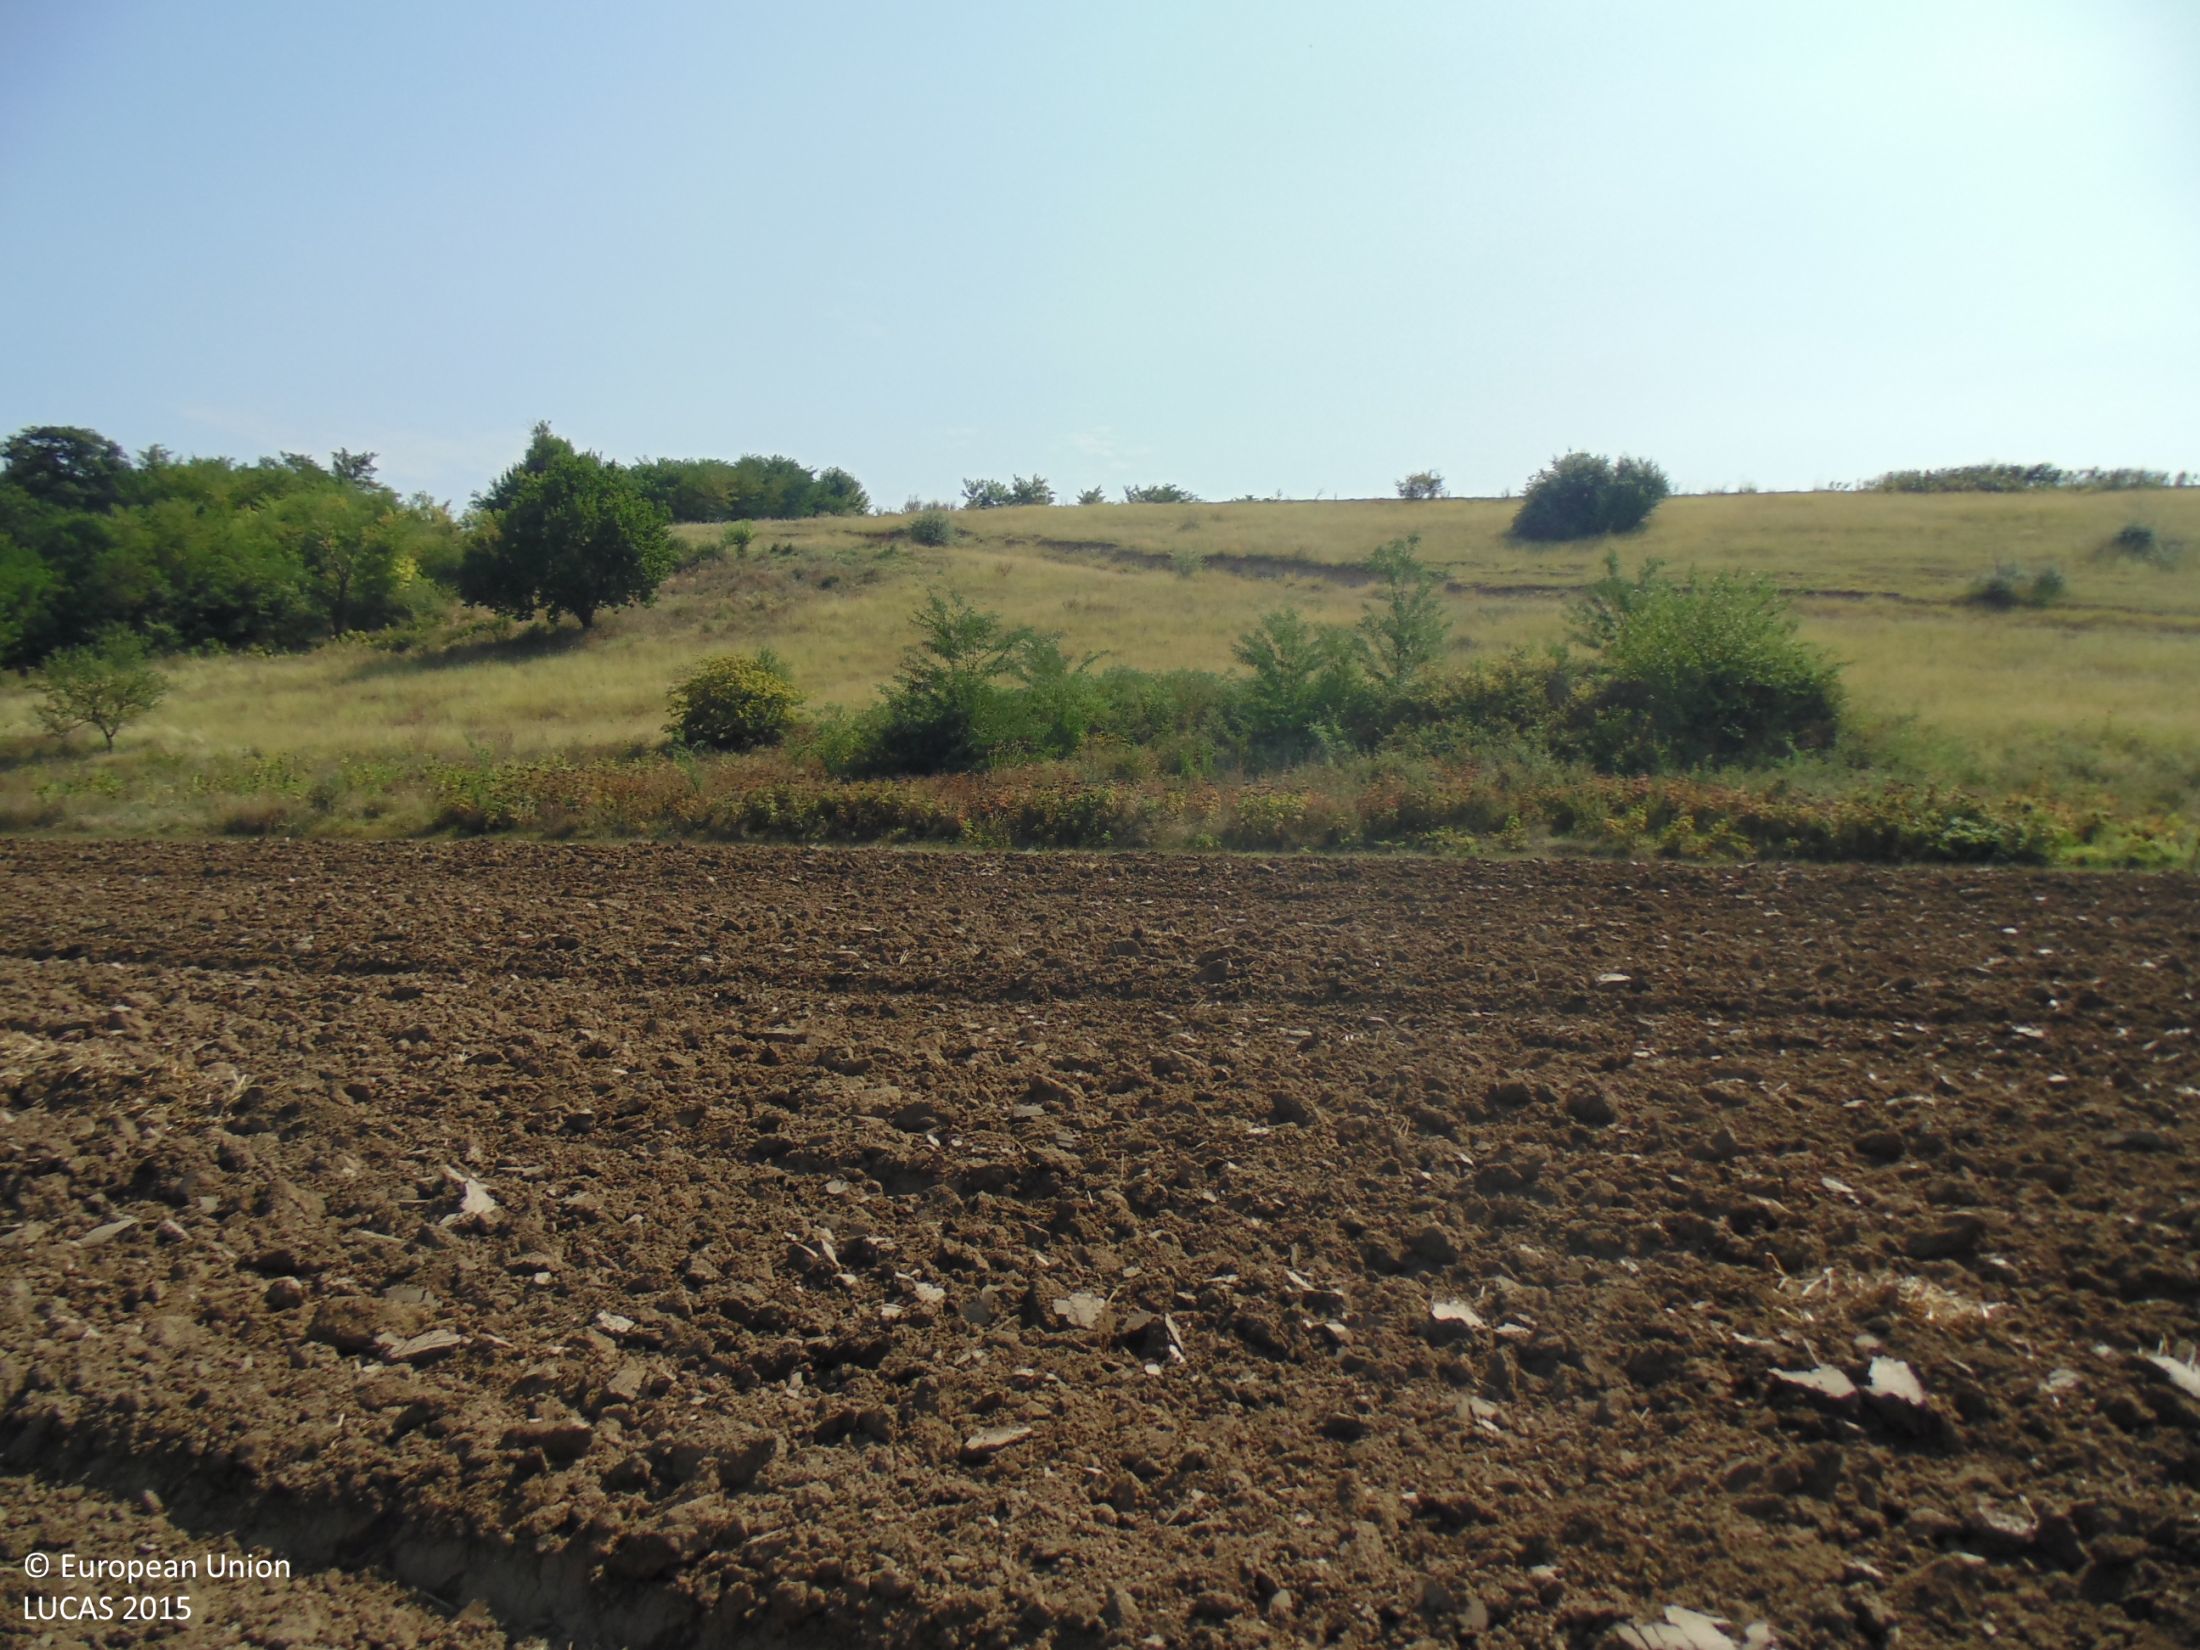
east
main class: Cropland
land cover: Common wheat
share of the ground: < 10 %
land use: Agriculture (excluding fallow land and kitchen gardens)
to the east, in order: Common wheat; Grass margins; Tracks; Grassland with sparse tree/shrub cover; Grassland without tree/shrub cover; Tracks; Grassland without tree/shrub cover; Common wheat; Grassland without tree/shrub cover; Tracks; Sunflower
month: August
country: BG
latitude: 44.0412
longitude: 27.3167
